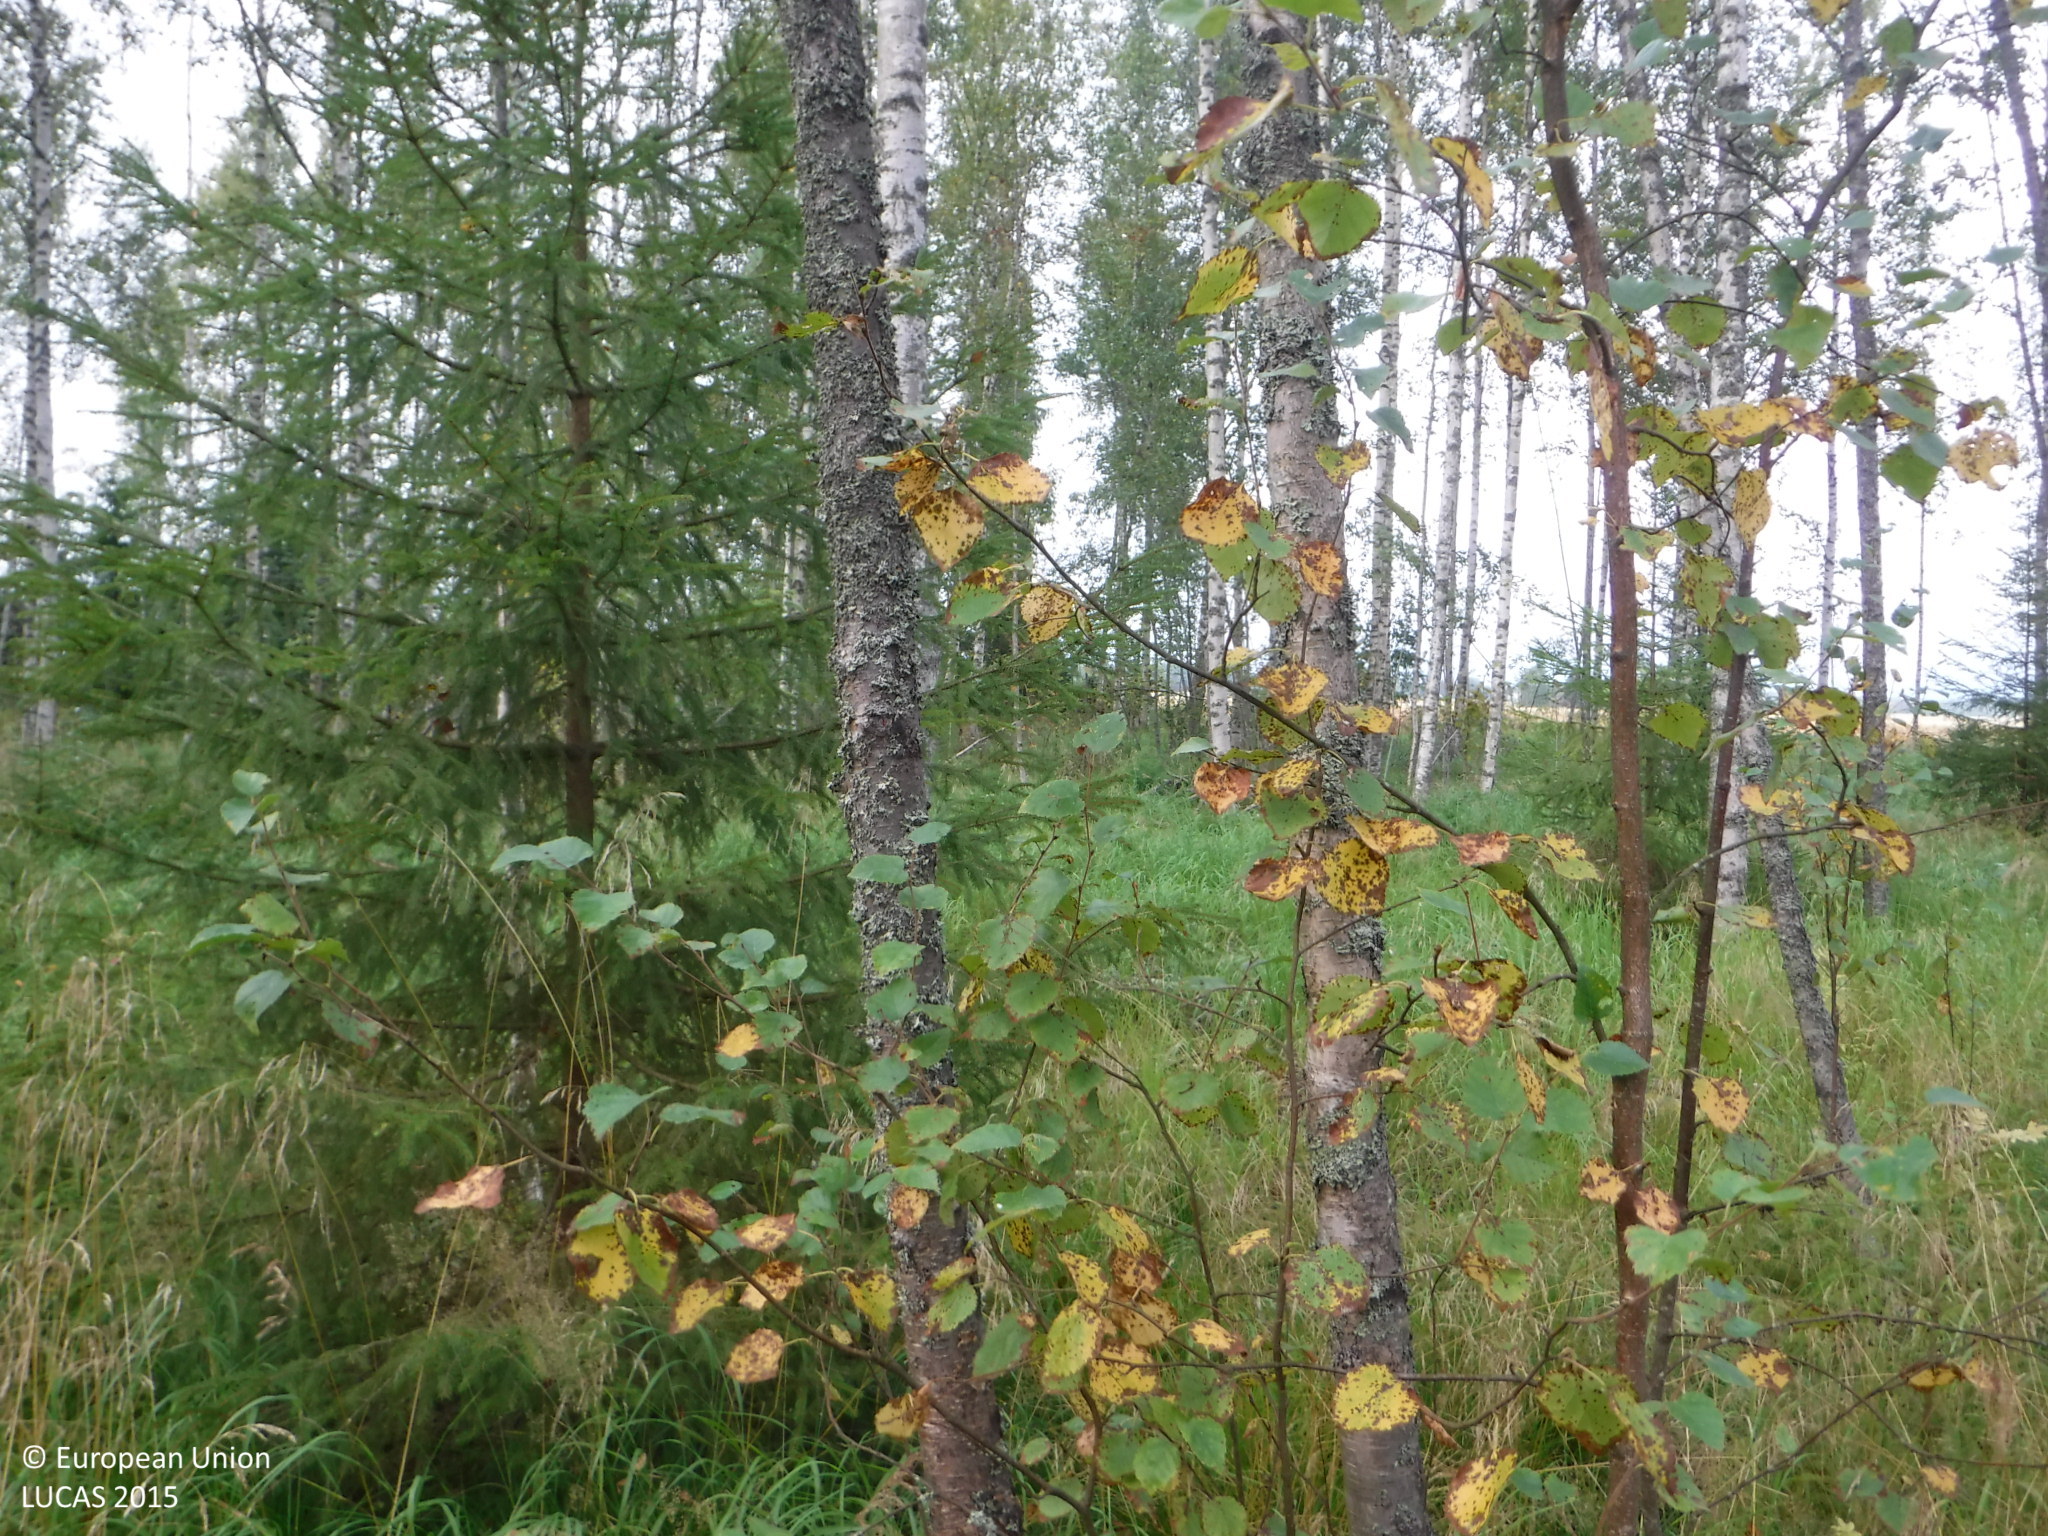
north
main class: Woodland
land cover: Broadleaved woodland
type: non-riverine alder, birch or aspen forest
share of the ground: 25 - 50 %
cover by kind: herbaceous plants 60 %, broadleaved forest trees 35 %, shrubs 5 %
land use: Forestry
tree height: > 5 m
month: September
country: FI
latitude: 61.3479
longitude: 21.9662
